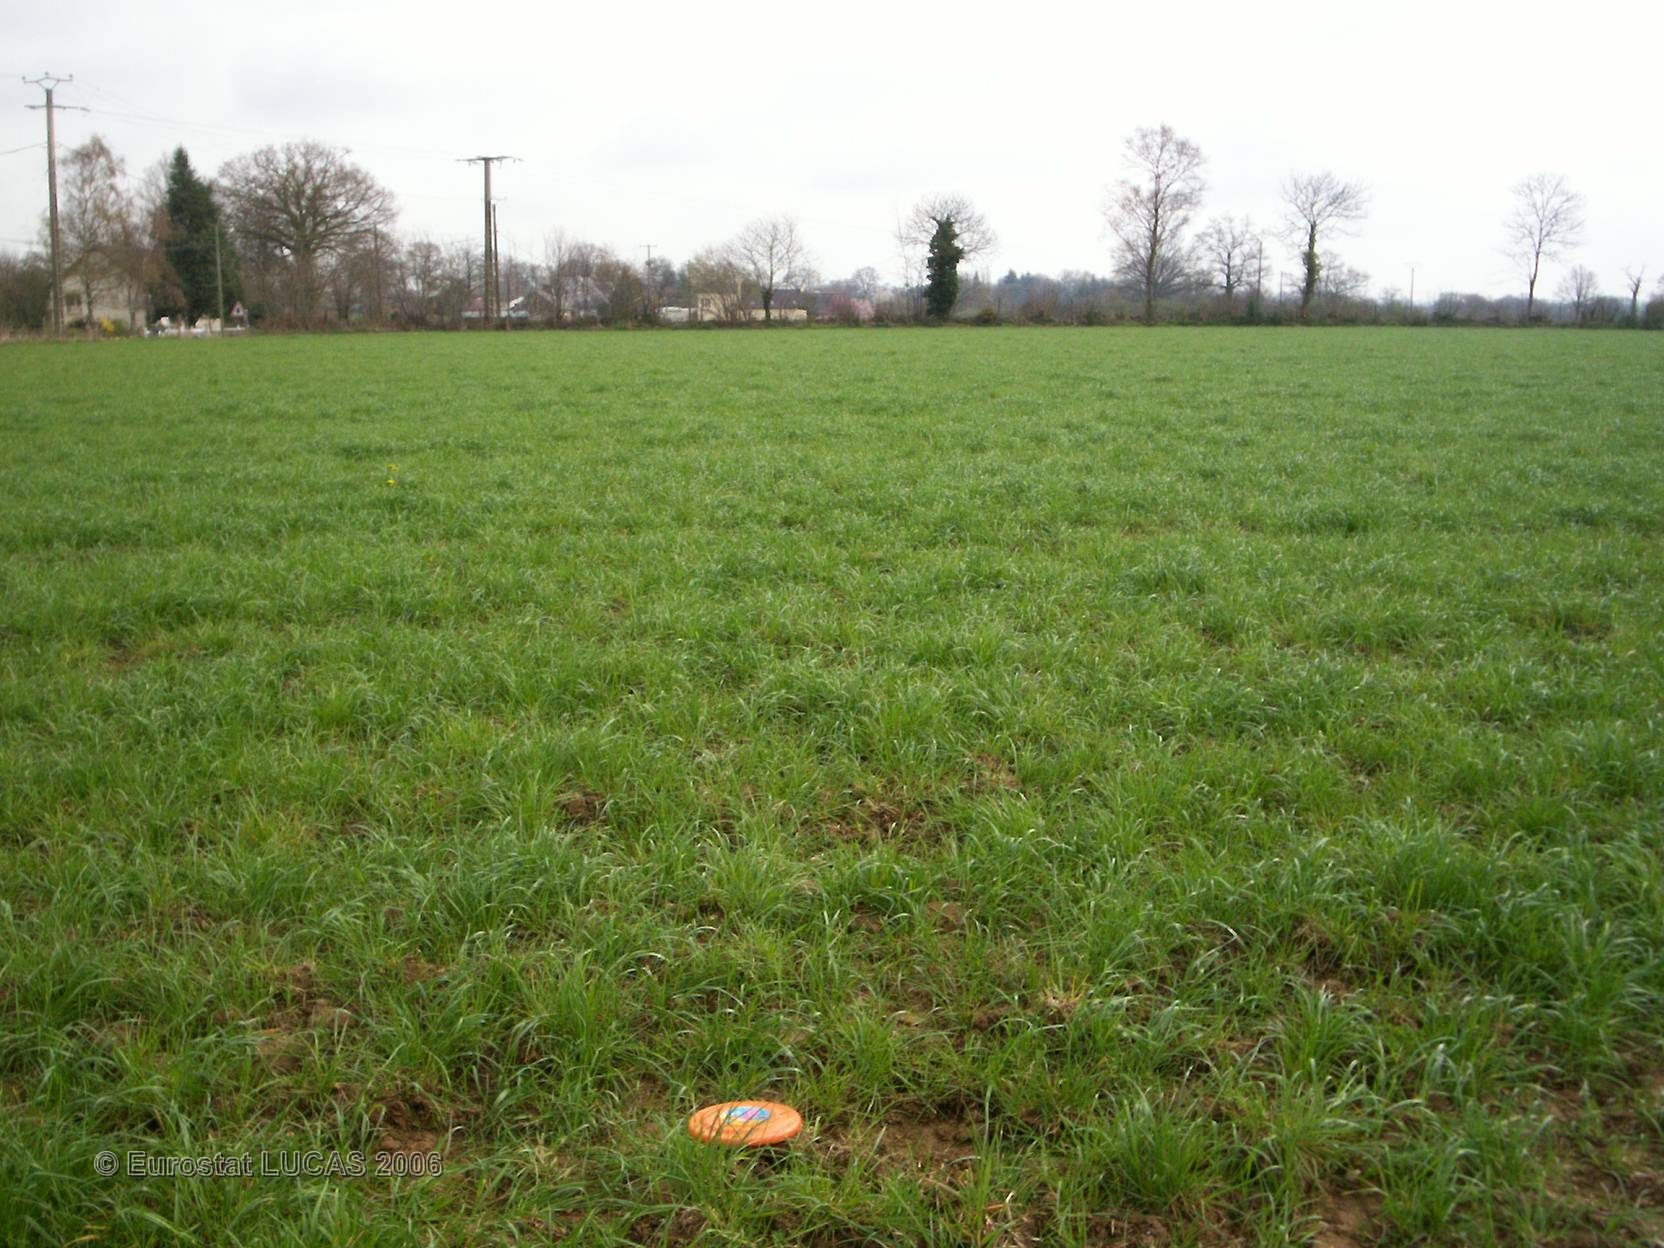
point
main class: Grassland
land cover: Grassland without tree/shrub cover
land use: Agriculture (excluding fallow land and kitchen gardens)
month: April
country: FR
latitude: 48.0924
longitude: -1.1447
